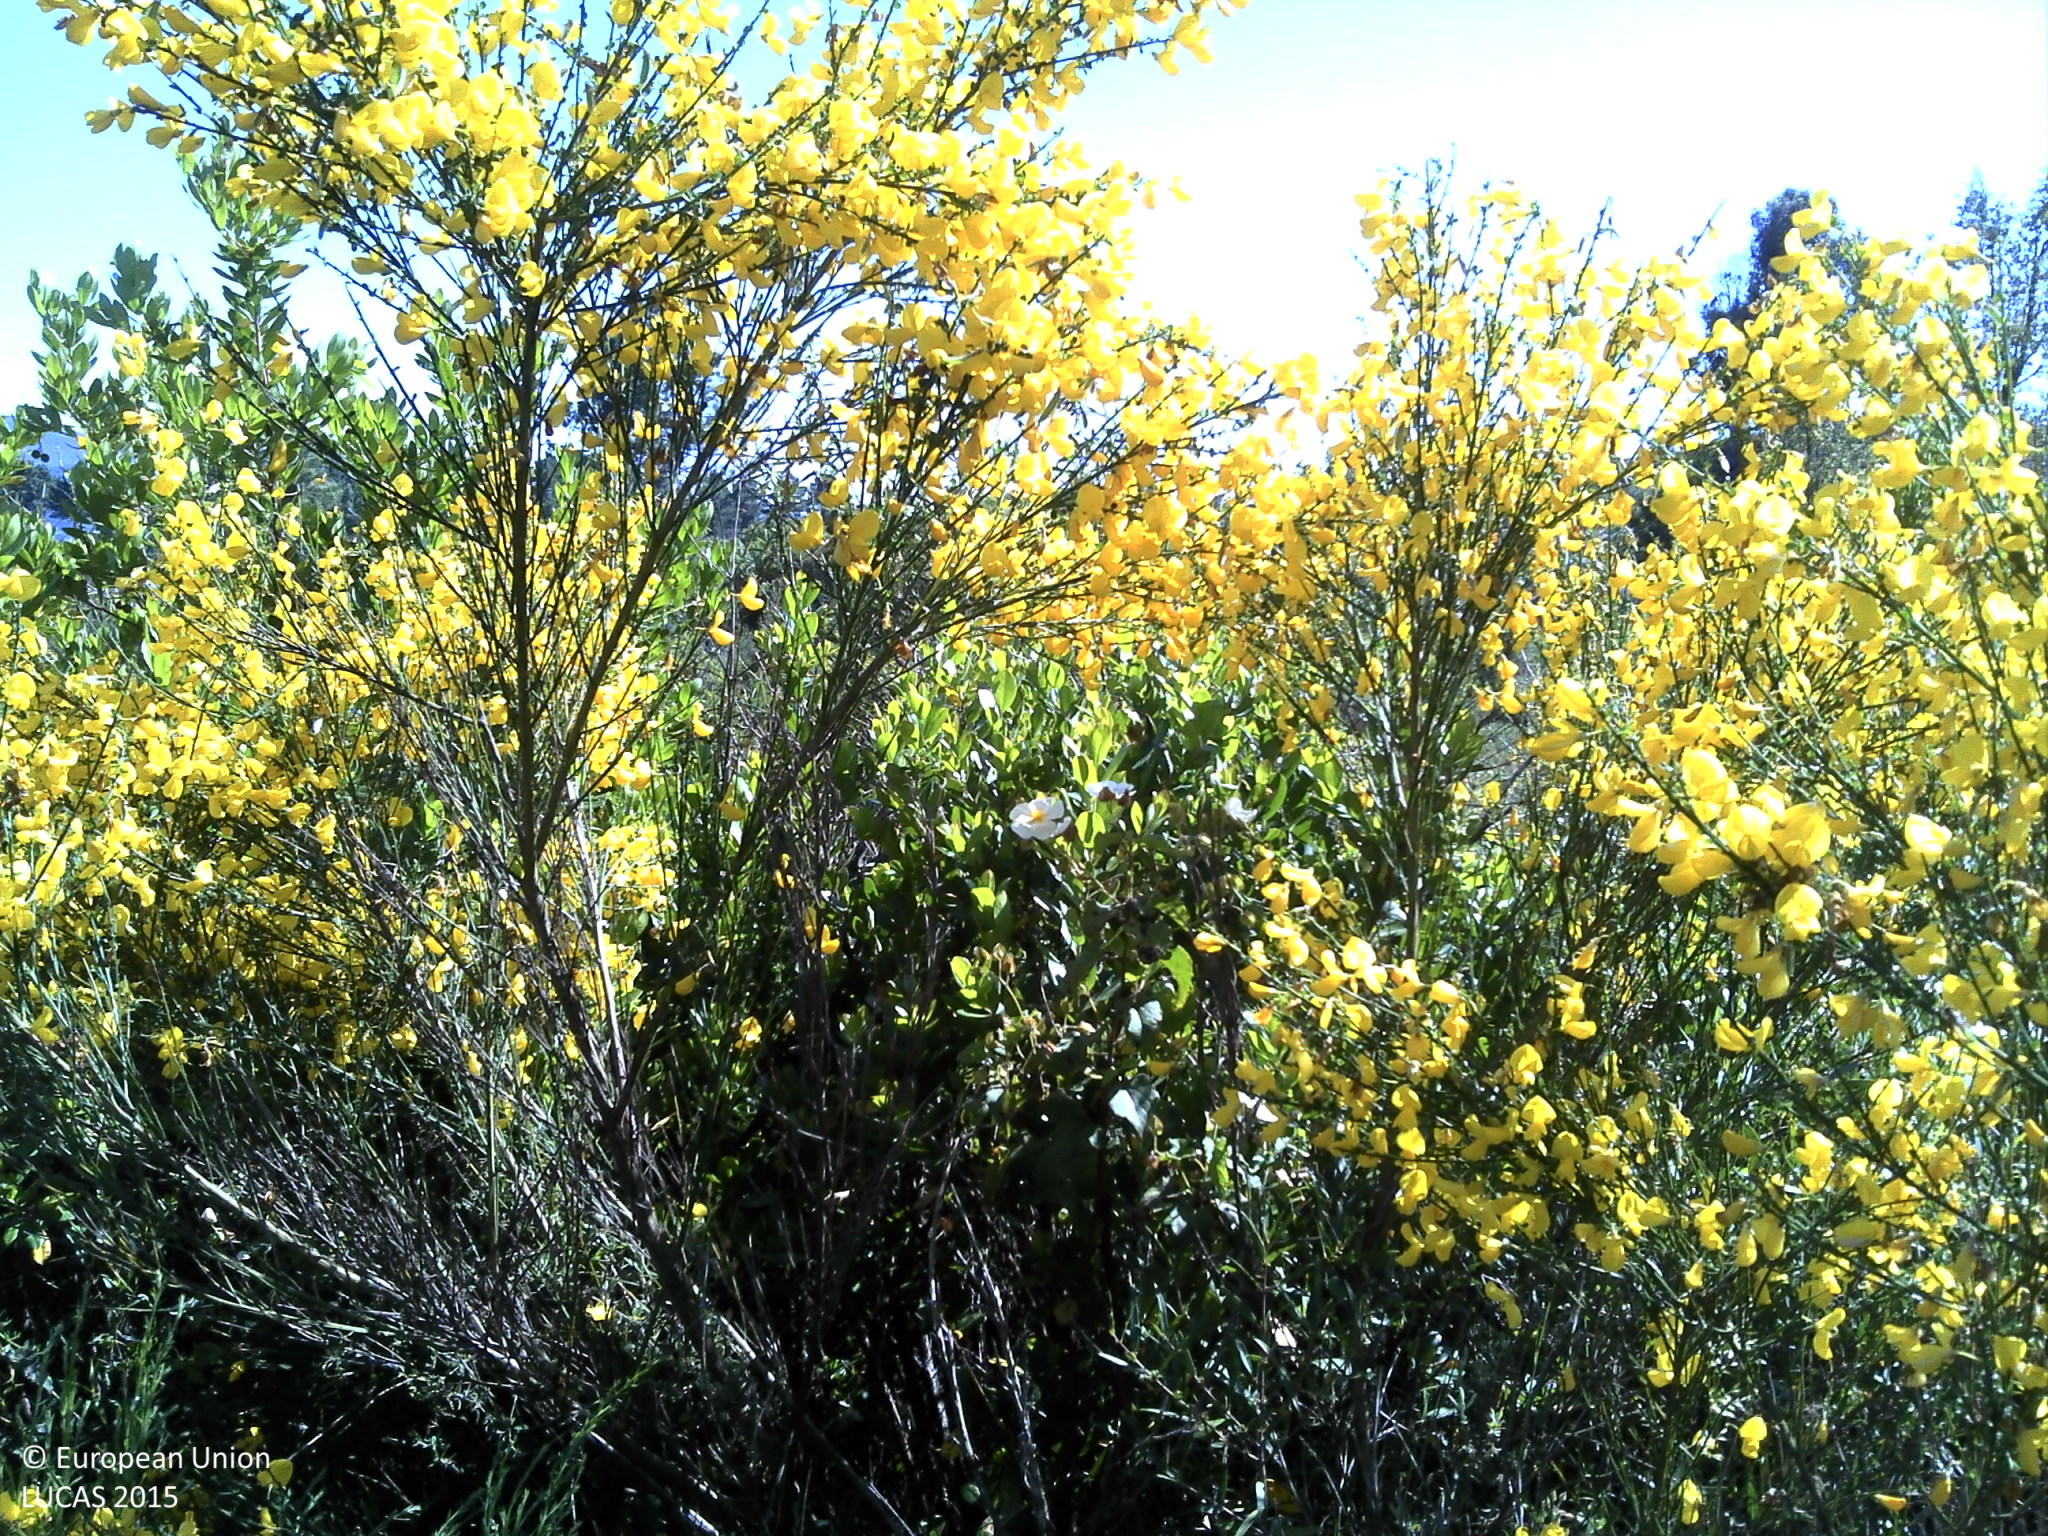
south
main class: Shrubland
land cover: Shrubland with sparse tree cover
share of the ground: > 75 %
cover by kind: shrubs 95 %, coniferous forest trees 5 %
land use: Forestry
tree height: > 5 m
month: May
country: PT
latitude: 41.5986
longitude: -7.5877
